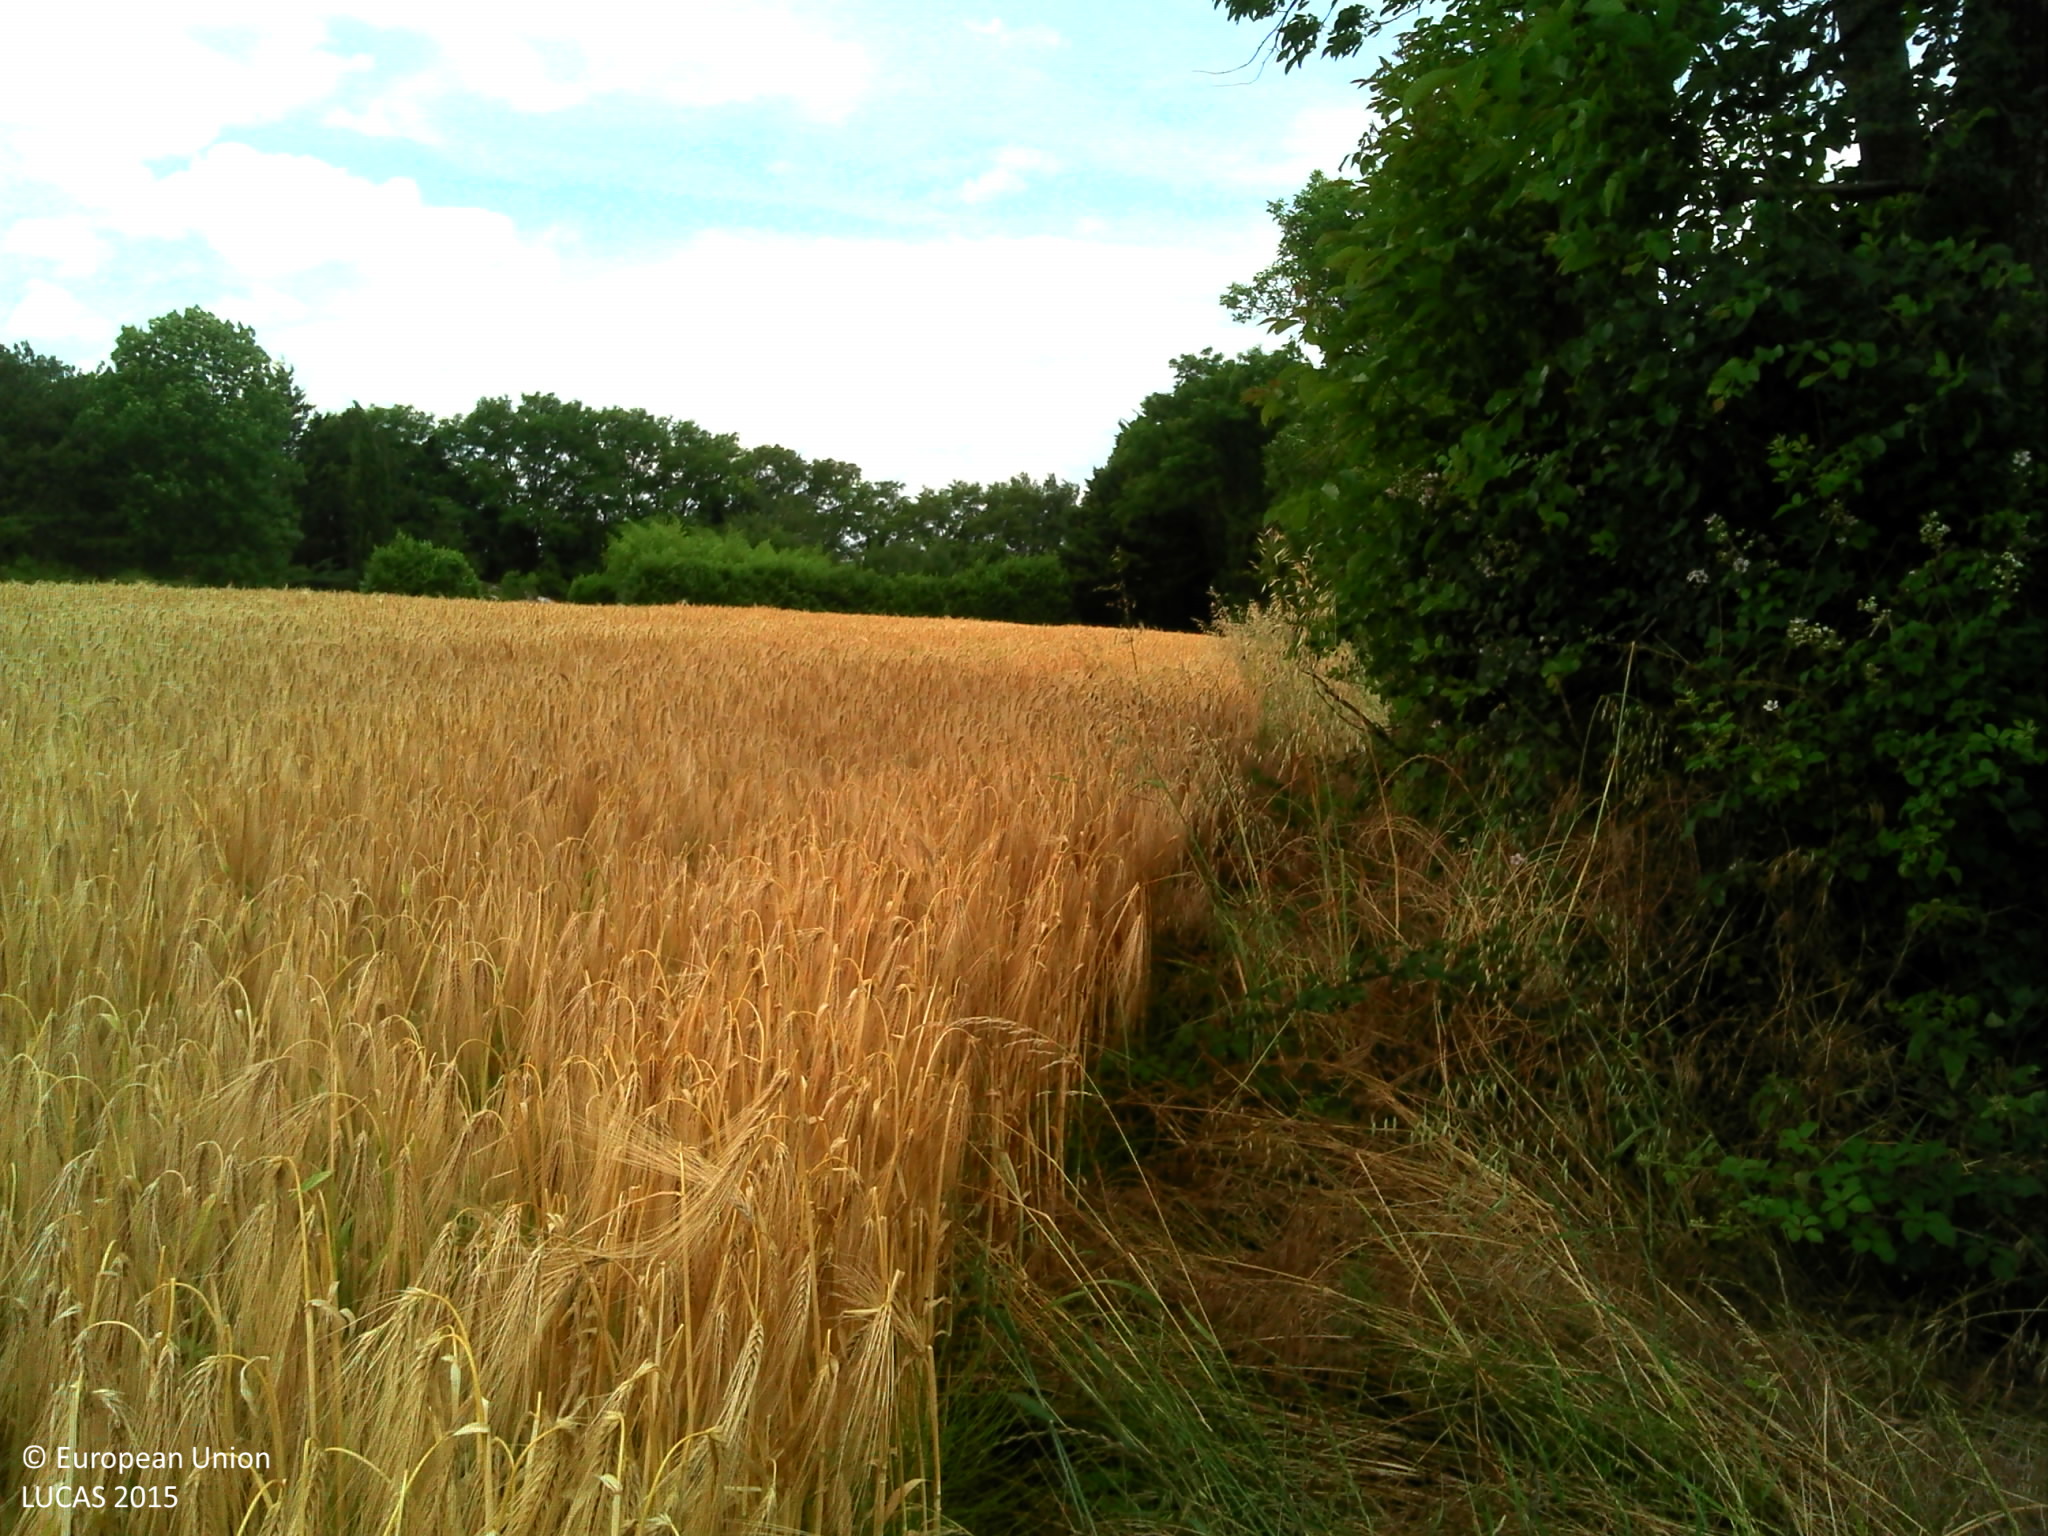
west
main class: Cropland
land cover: Barley
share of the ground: > 75 %
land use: Agriculture (excluding fallow land and kitchen gardens)
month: June
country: FR
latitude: 44.8279
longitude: 5.0354
